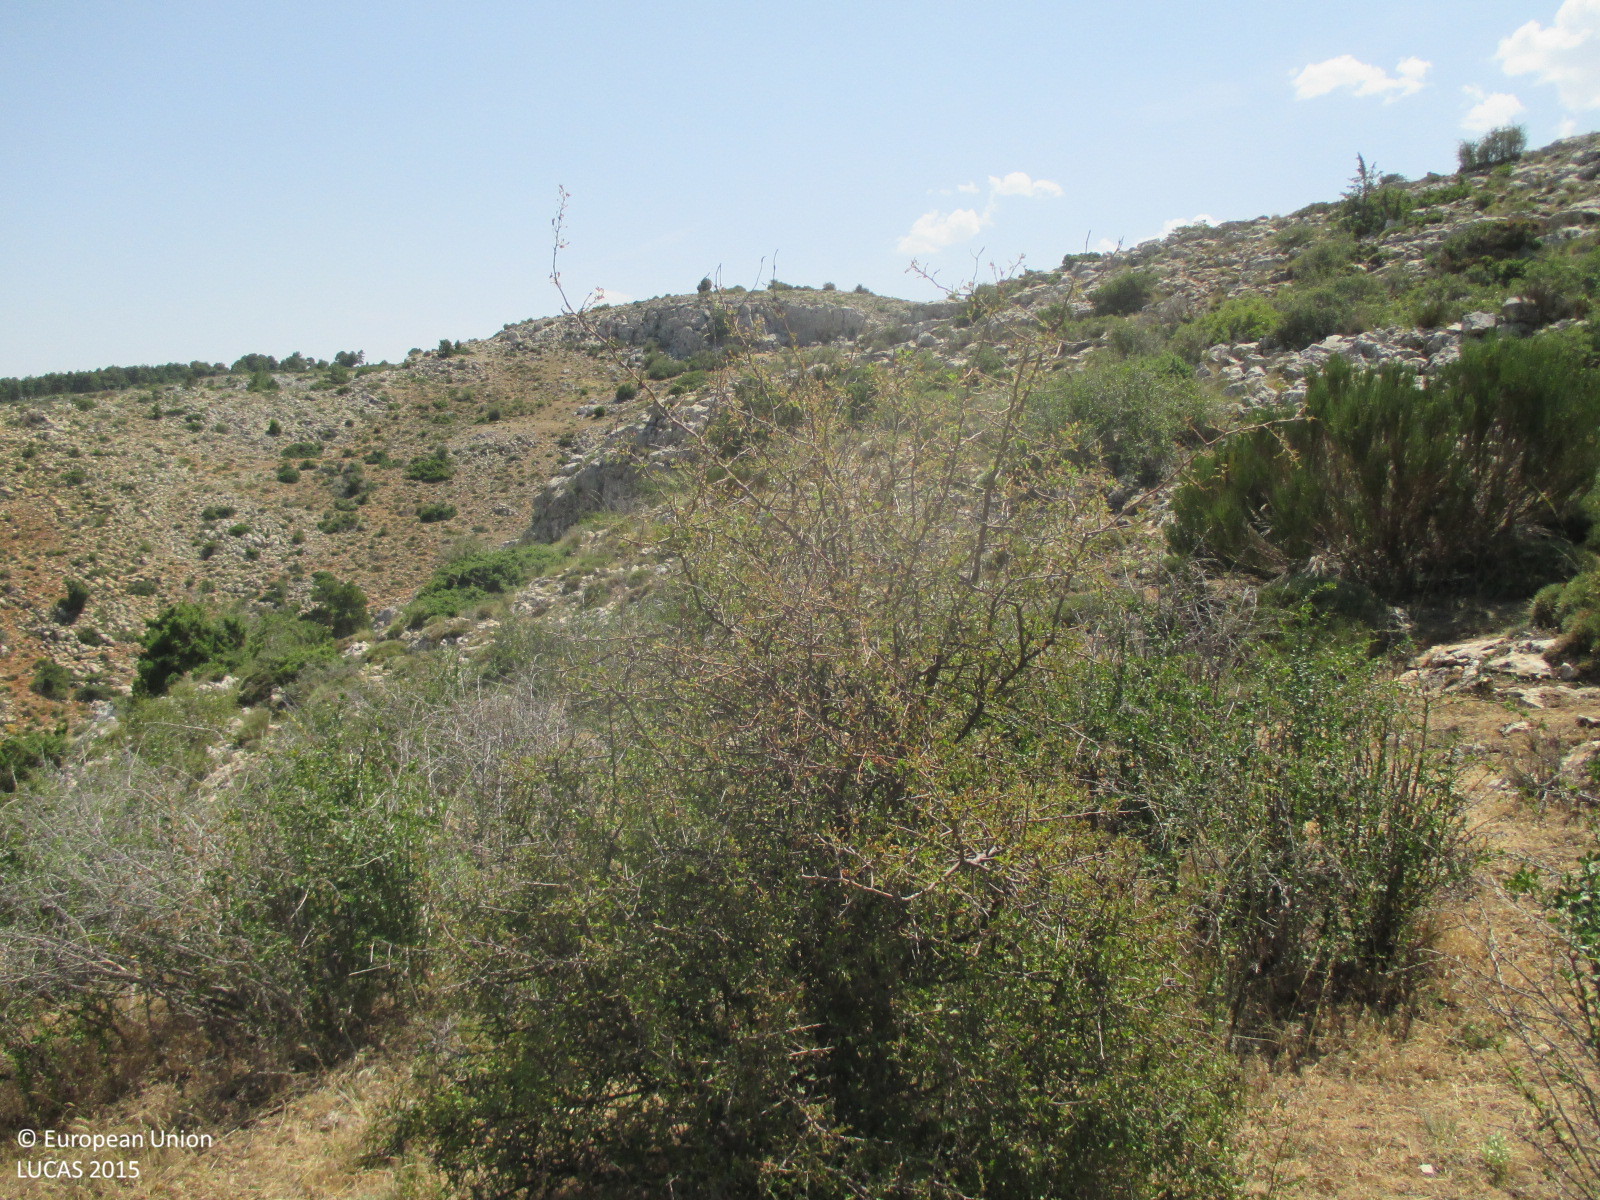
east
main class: Shrubland
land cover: Shrubland without tree cover
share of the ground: 50 - 75 %
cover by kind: shrubs 60 %, consolidated bare surface 30 %, herbaceous plants 10 %
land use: Semi-natural and natural areas not in use
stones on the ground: < 10 %
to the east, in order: Shrubland without tree cover; Rocks and stones; Rivers and streams; Rocks and stones; Shrubland without tree cover
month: July
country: ES
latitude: 38.0947
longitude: -2.4793
